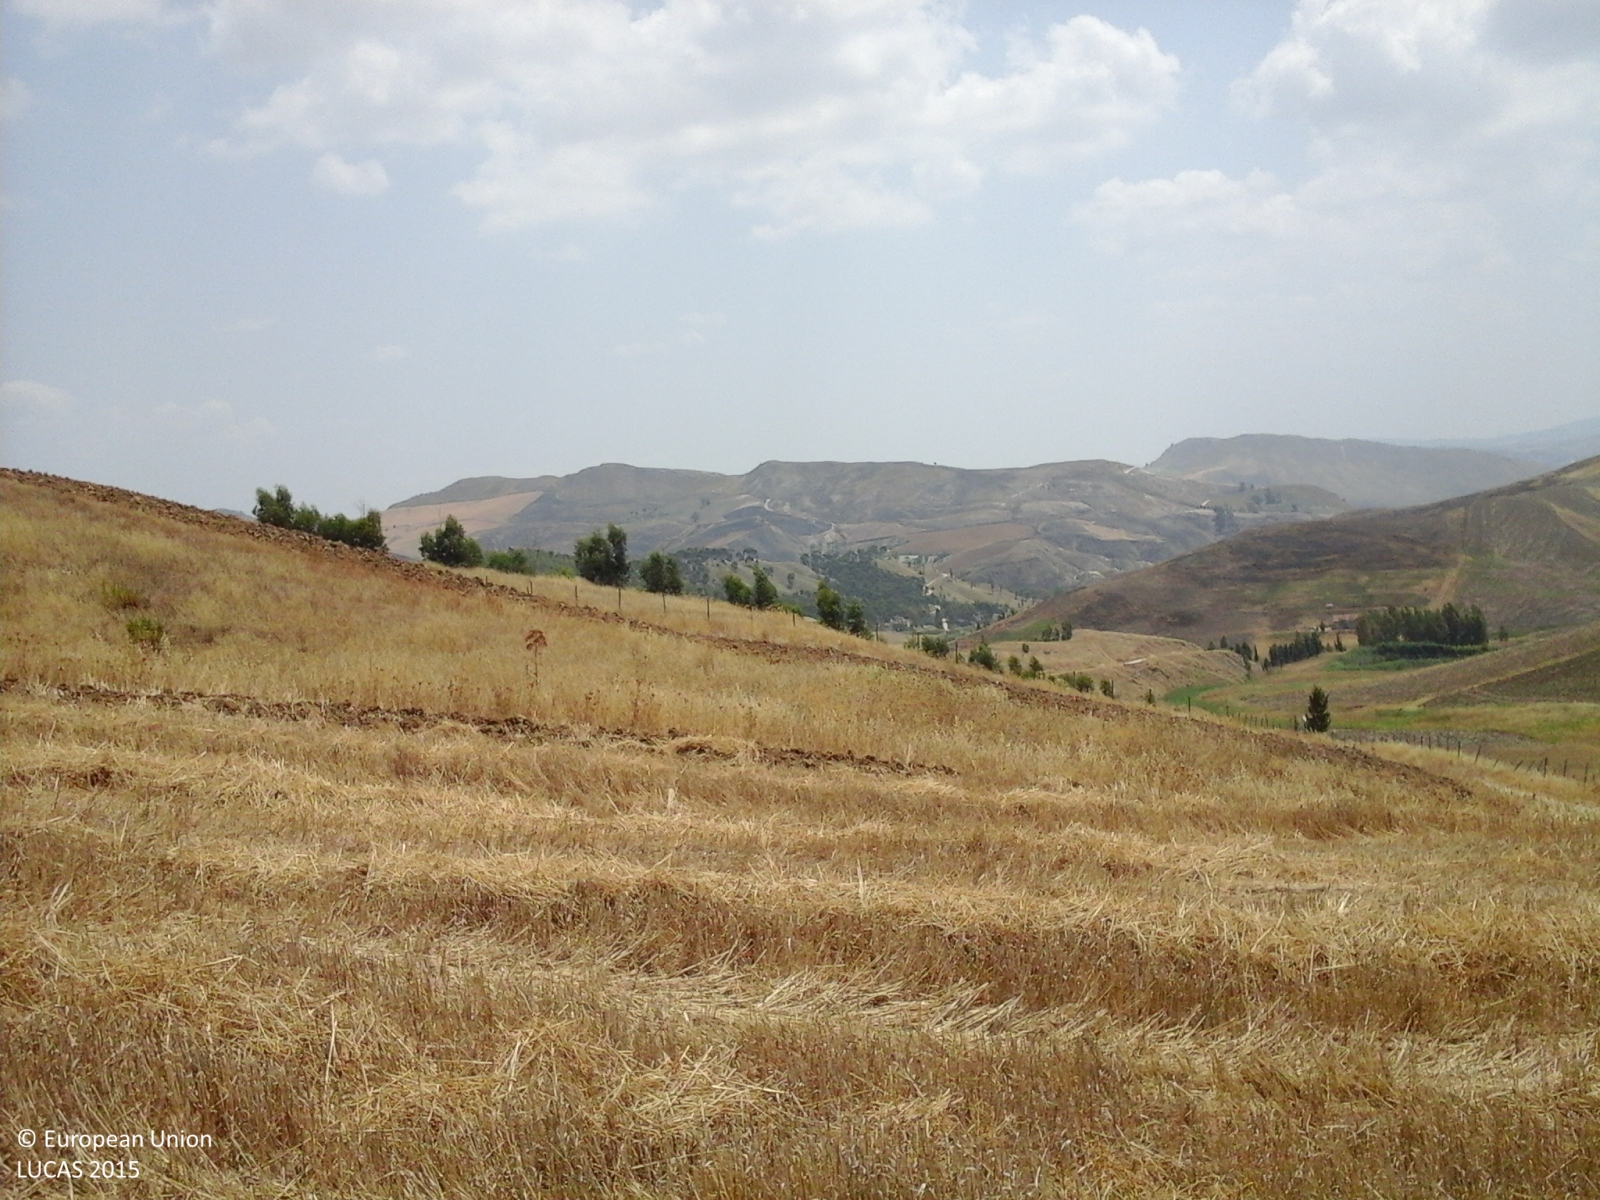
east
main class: Cropland
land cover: Durum wheat
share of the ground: > 75 %
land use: Agriculture (excluding fallow land and kitchen gardens)
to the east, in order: Durum wheat; Spontaneously vegetated surfaces; Other bare soil; Fences; Broadleaved woodland; Fences; Tracks; Fences; Grassland without tree/shrub cover; Tracks; Grassland without tree/shrub cover
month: July
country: IT
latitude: 37.3353
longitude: 14.0211
